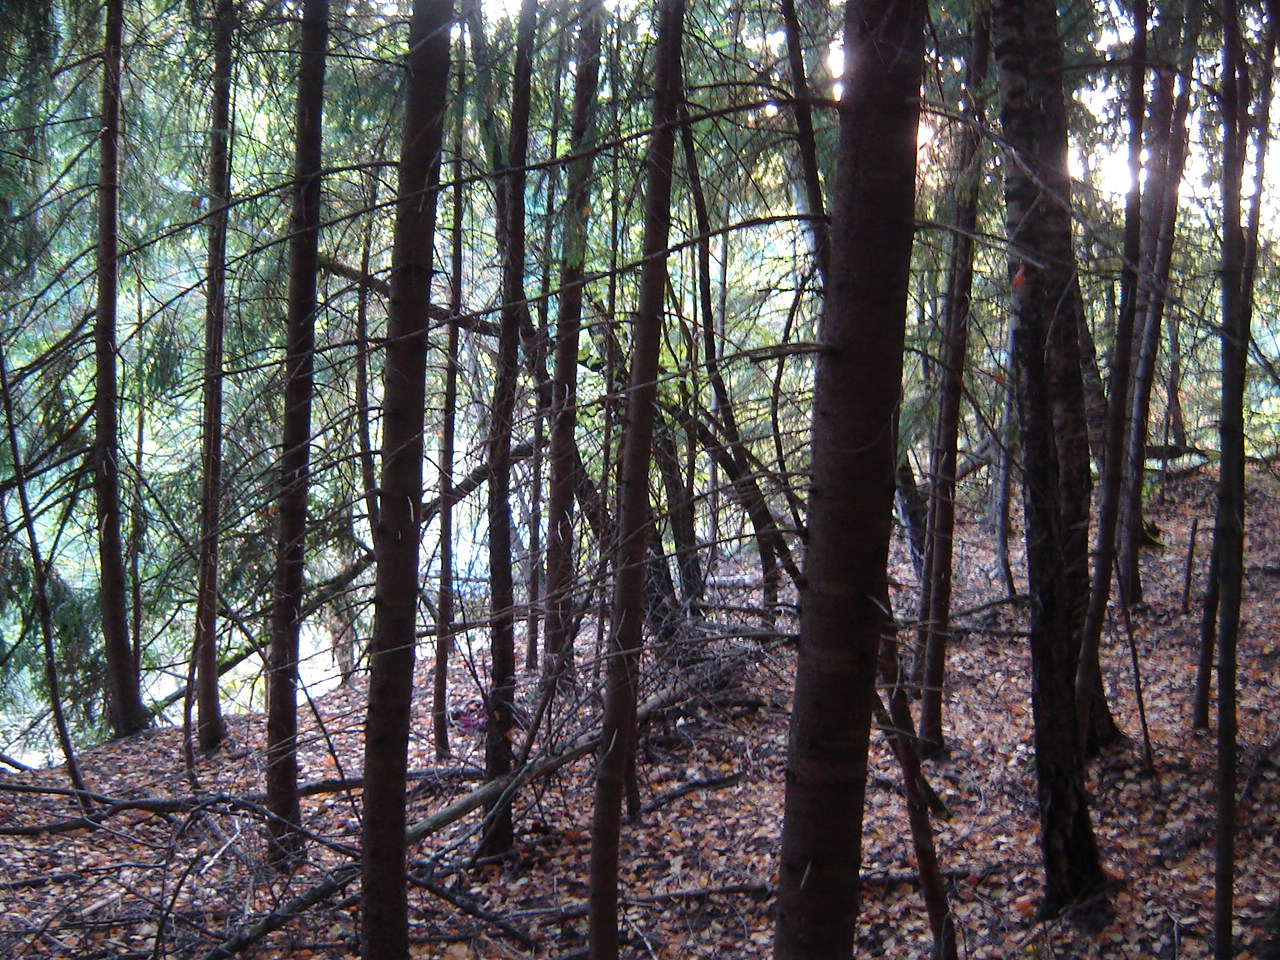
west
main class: Woodland
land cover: Pine dominated mixed woodland
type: hemiboreal forest and nemoral coniferous forest and mixed broadleaved-coniferous forest
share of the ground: > 75 %
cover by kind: coniferous forest trees 70 %, broadleaved forest trees 25 %, unconsolidated bare surface 5 %
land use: Forestry
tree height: > 5 m
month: August
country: LT
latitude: 54.7161
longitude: 24.9695
